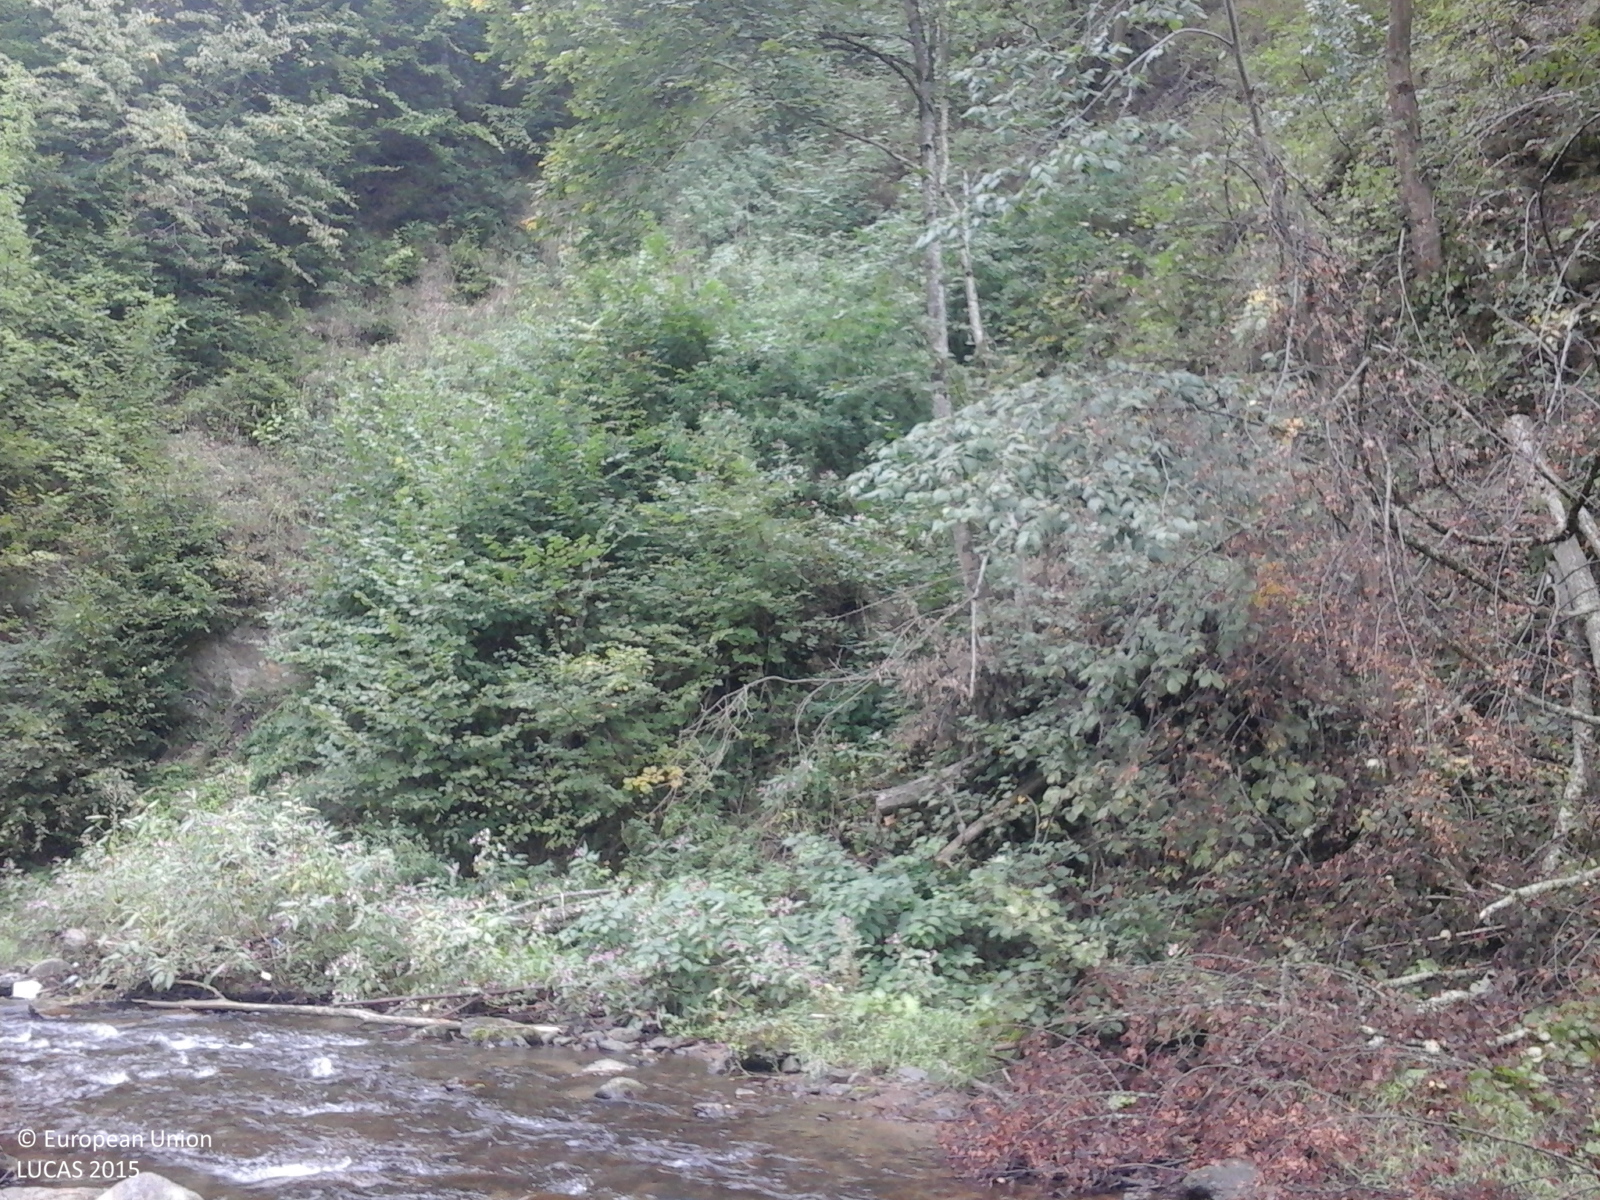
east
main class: Woodland
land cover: Broadleaved woodland
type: beech forest
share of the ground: > 75 %
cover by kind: broadleaved forest trees 100 %
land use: Forestry
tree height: > 5 m
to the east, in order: Broadleaved woodland
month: September
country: RO
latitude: 46.6713
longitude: 23.2535
